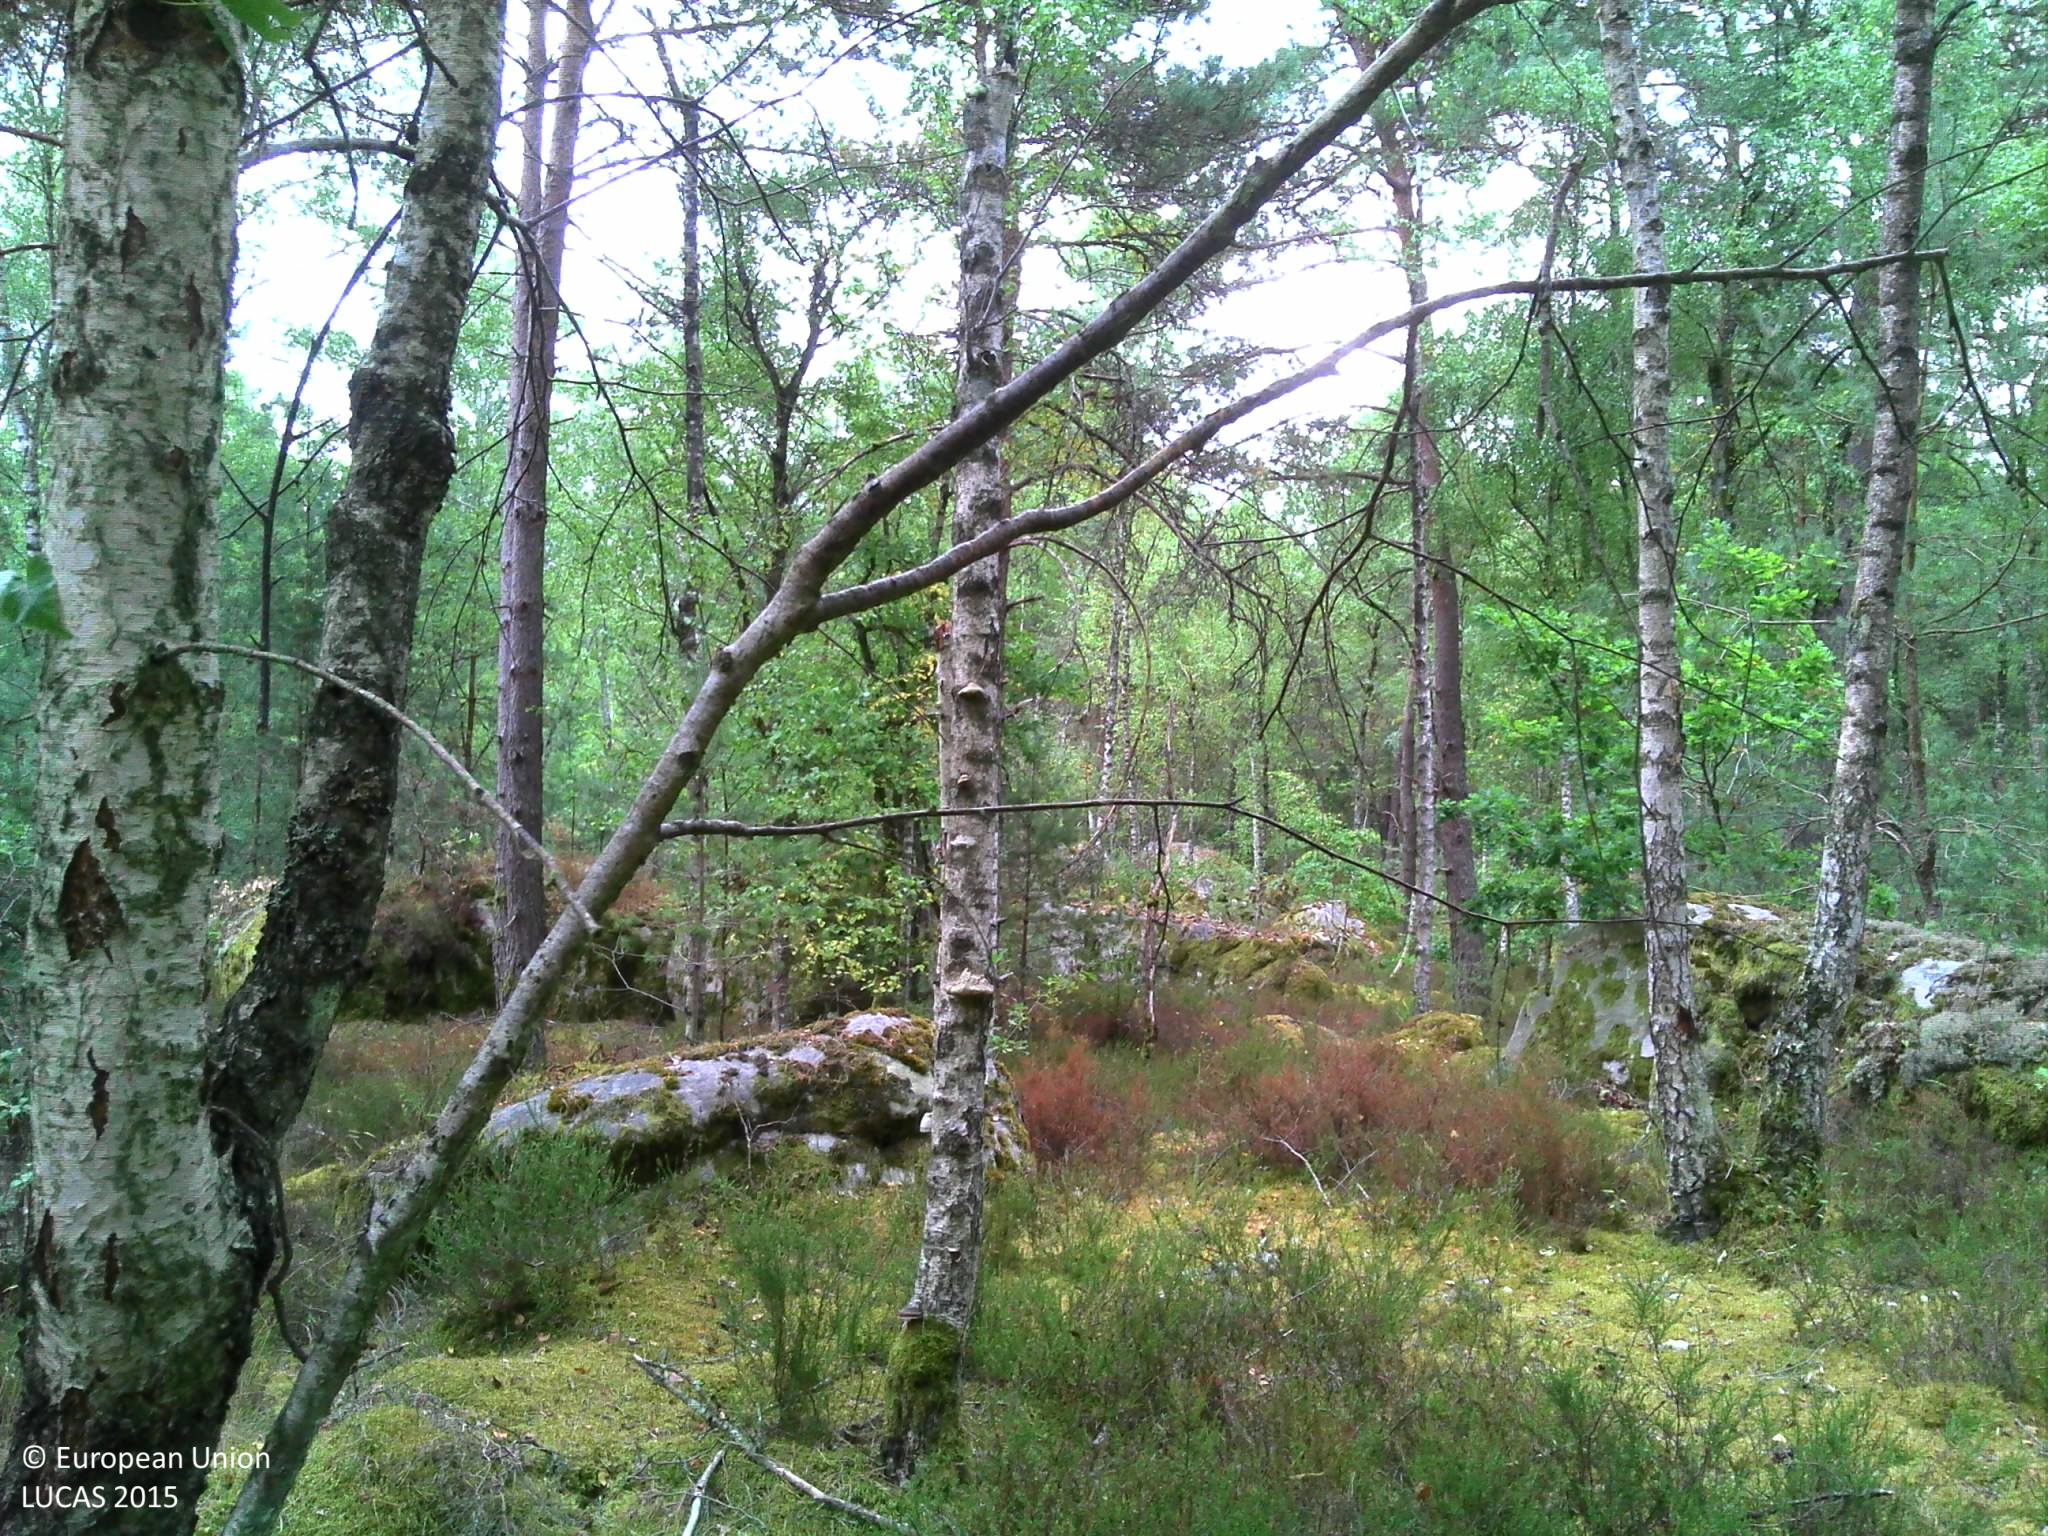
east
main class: Woodland
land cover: Pine dominated mixed woodland
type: non-riverine alder, birch or aspen forest
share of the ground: > 75 %
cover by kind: lichens and mosses 40 %, coniferous forest trees 30 %, shrubs 20 %, broadleaved forest trees 10 %
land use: Forestry
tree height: > 5 m
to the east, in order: Pine dominated mixed woodland; Tracks; Pine dominated mixed woodland
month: August
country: FR
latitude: 48.3671
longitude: 2.5251
